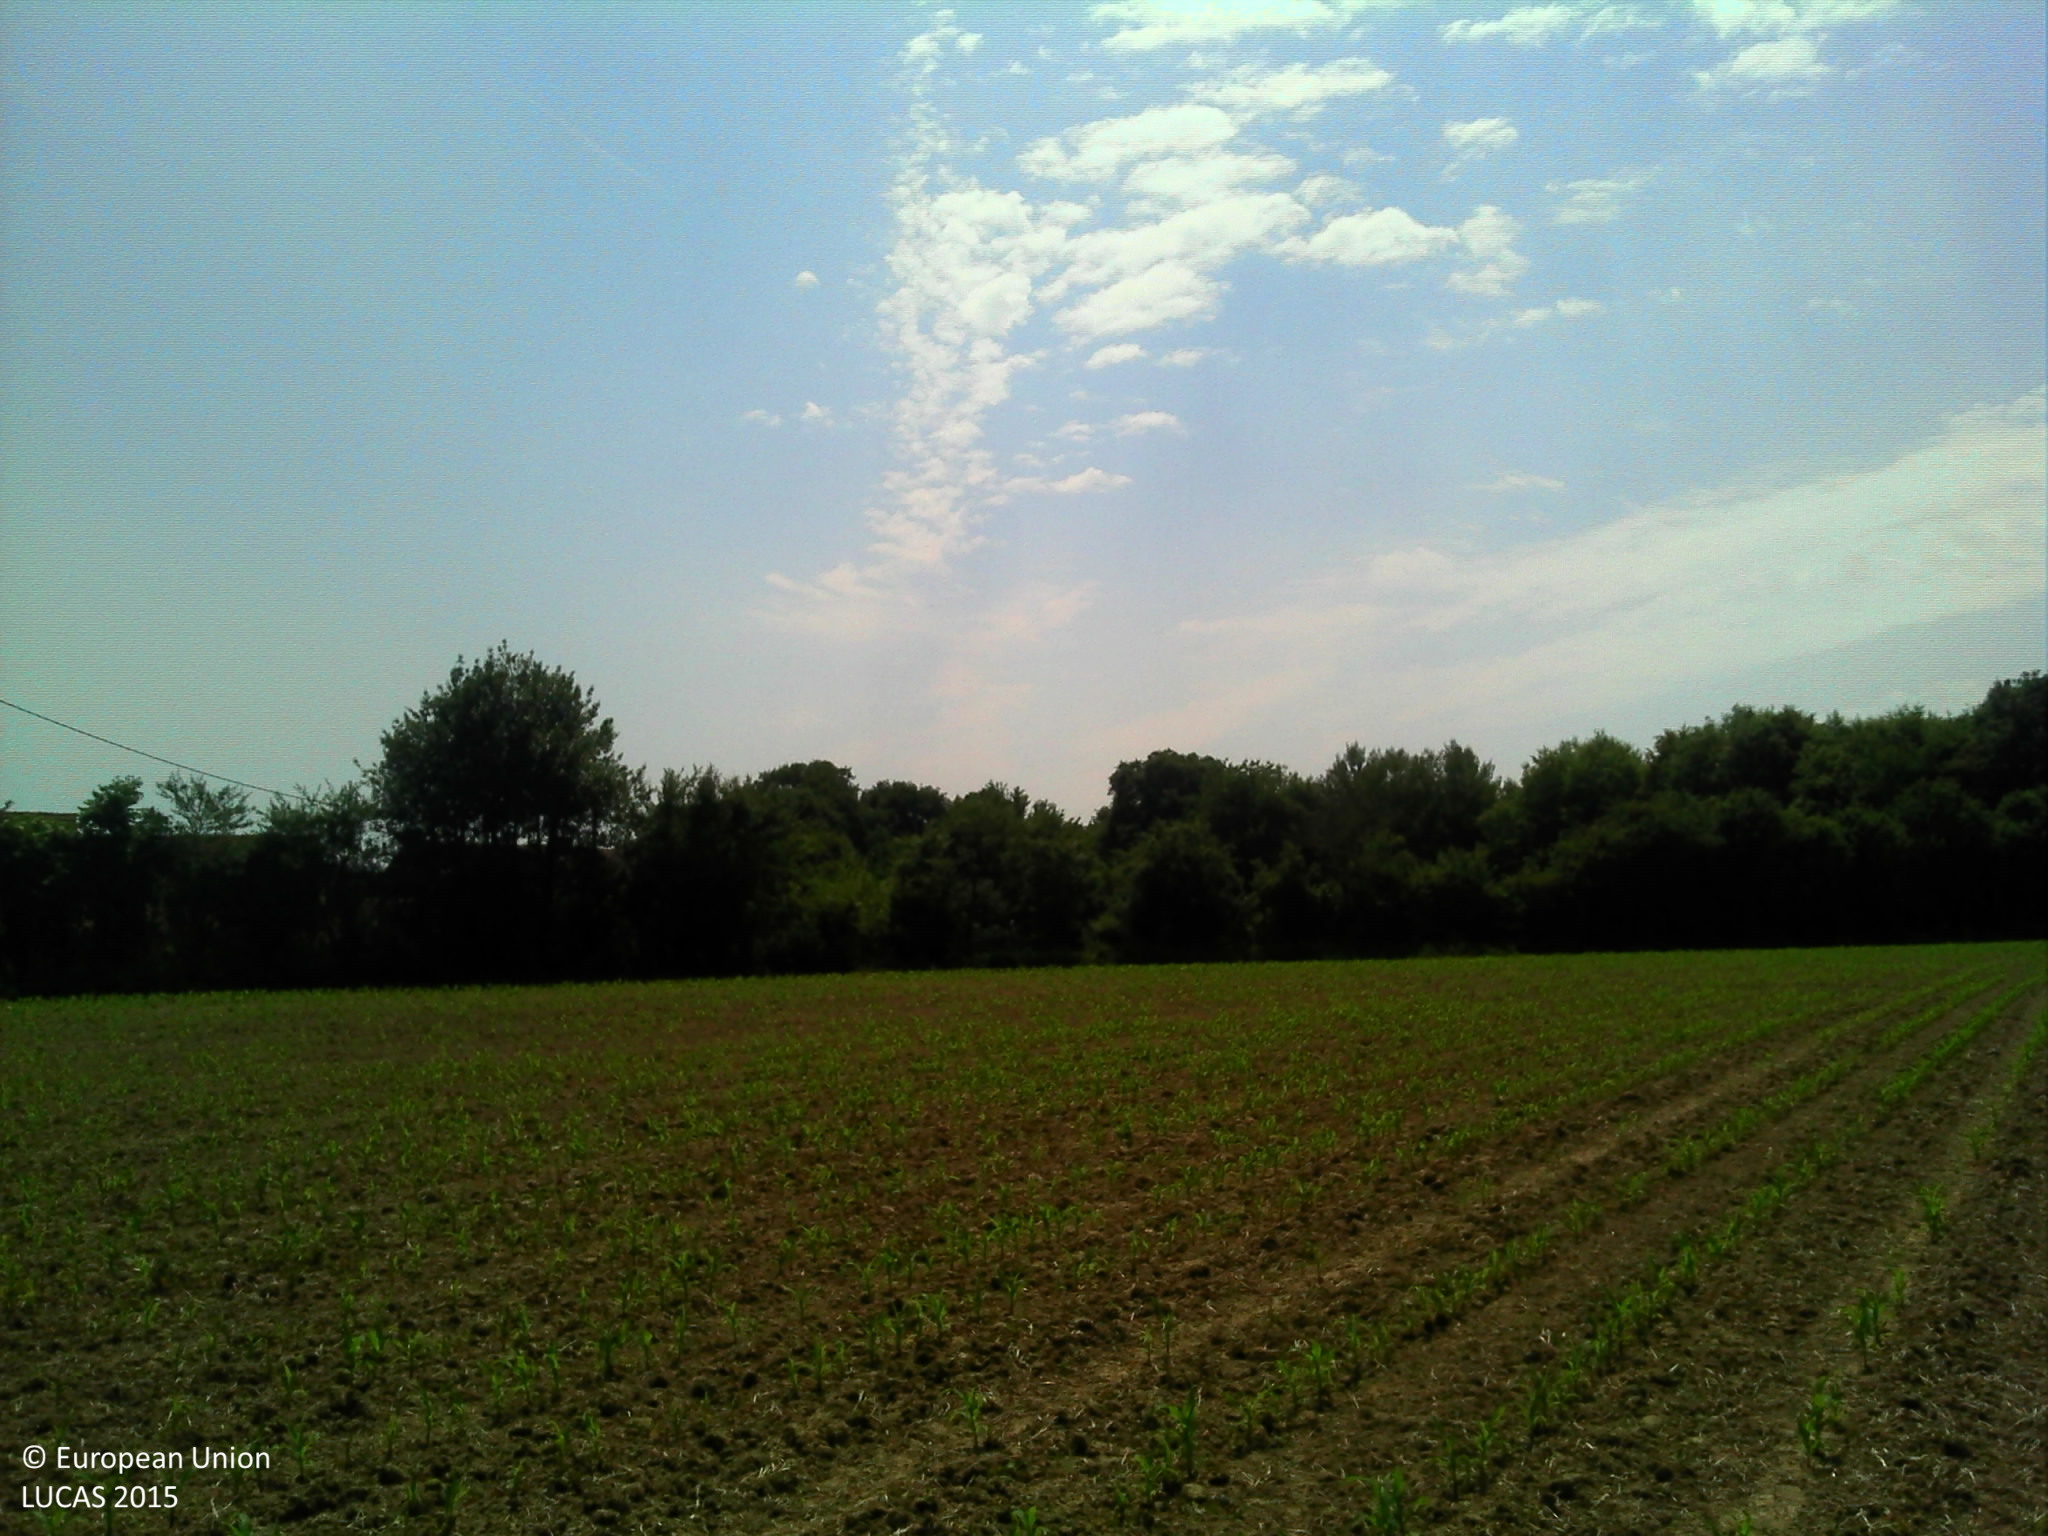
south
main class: Cropland
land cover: Maize
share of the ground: 25 - 50 %
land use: Agriculture (excluding fallow land and kitchen gardens)
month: June
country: FR
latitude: 47.9512
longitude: 0.0237
